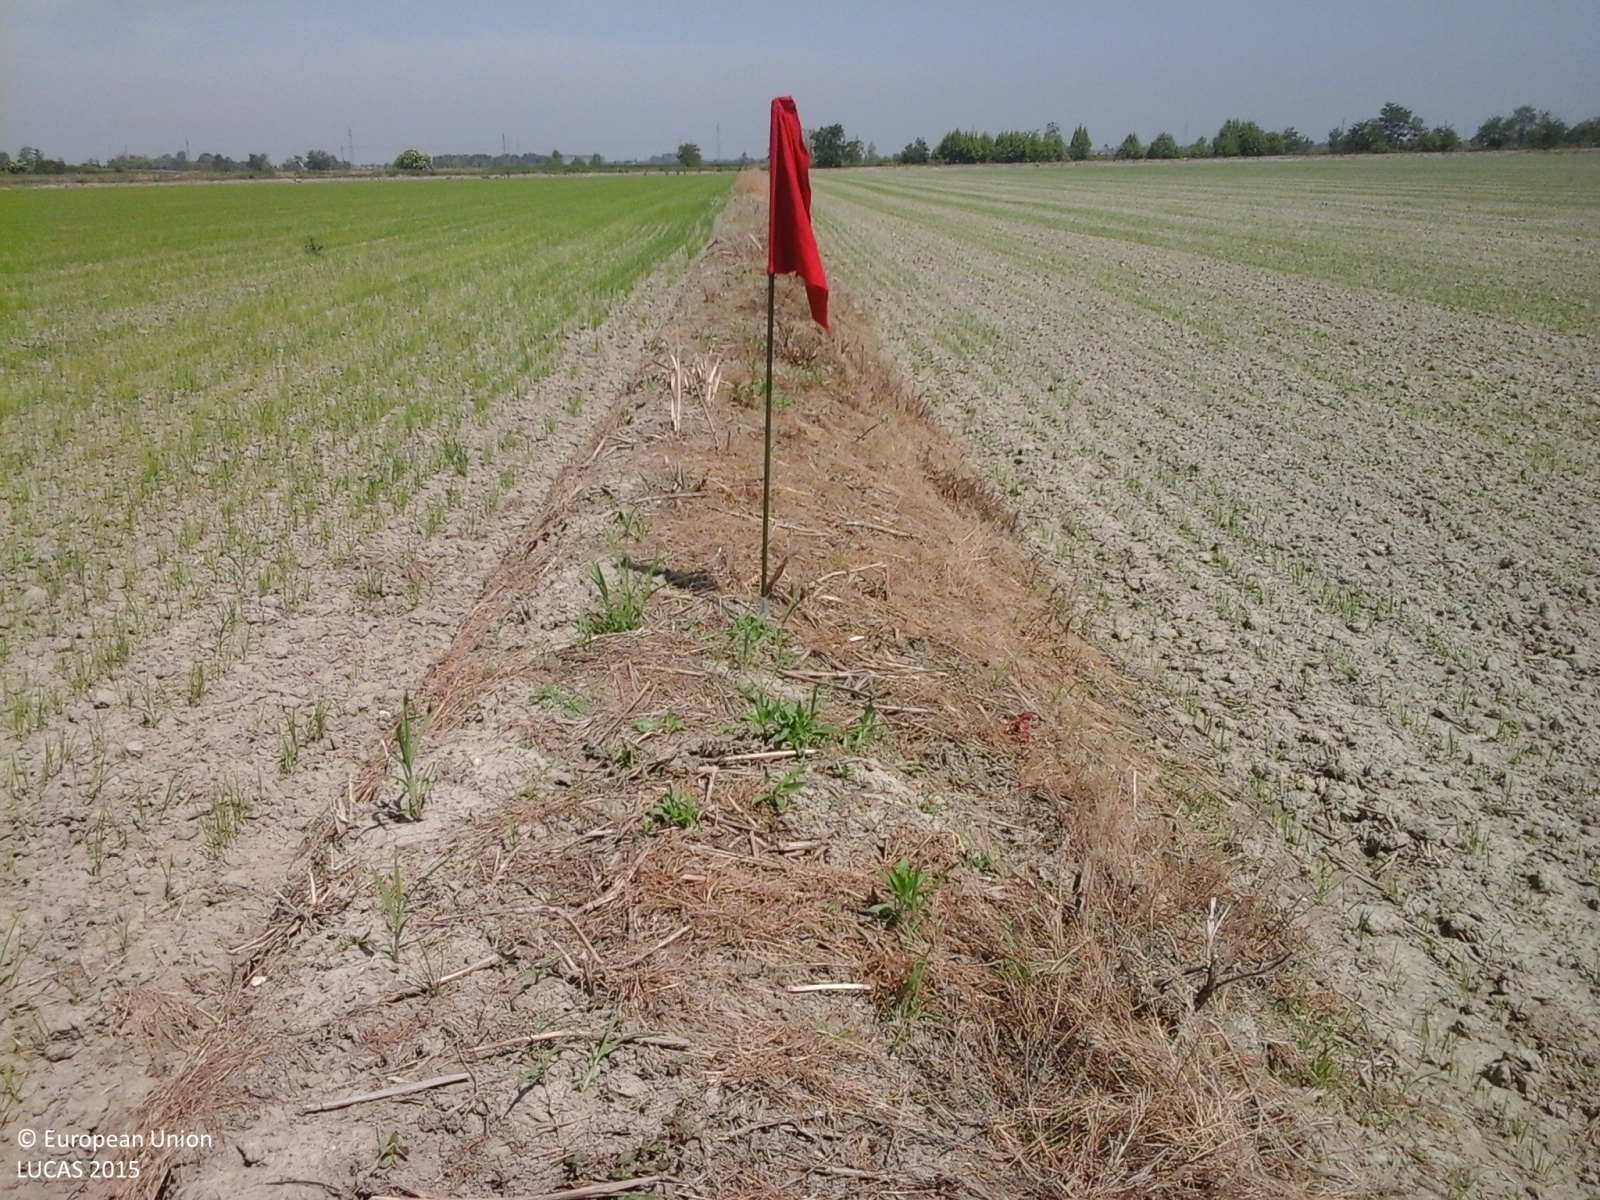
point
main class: Cropland
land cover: Rice
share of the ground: 10 - 25 %
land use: Agriculture (excluding fallow land and kitchen gardens)
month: May
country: IT
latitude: 45.1676
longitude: 8.3871
